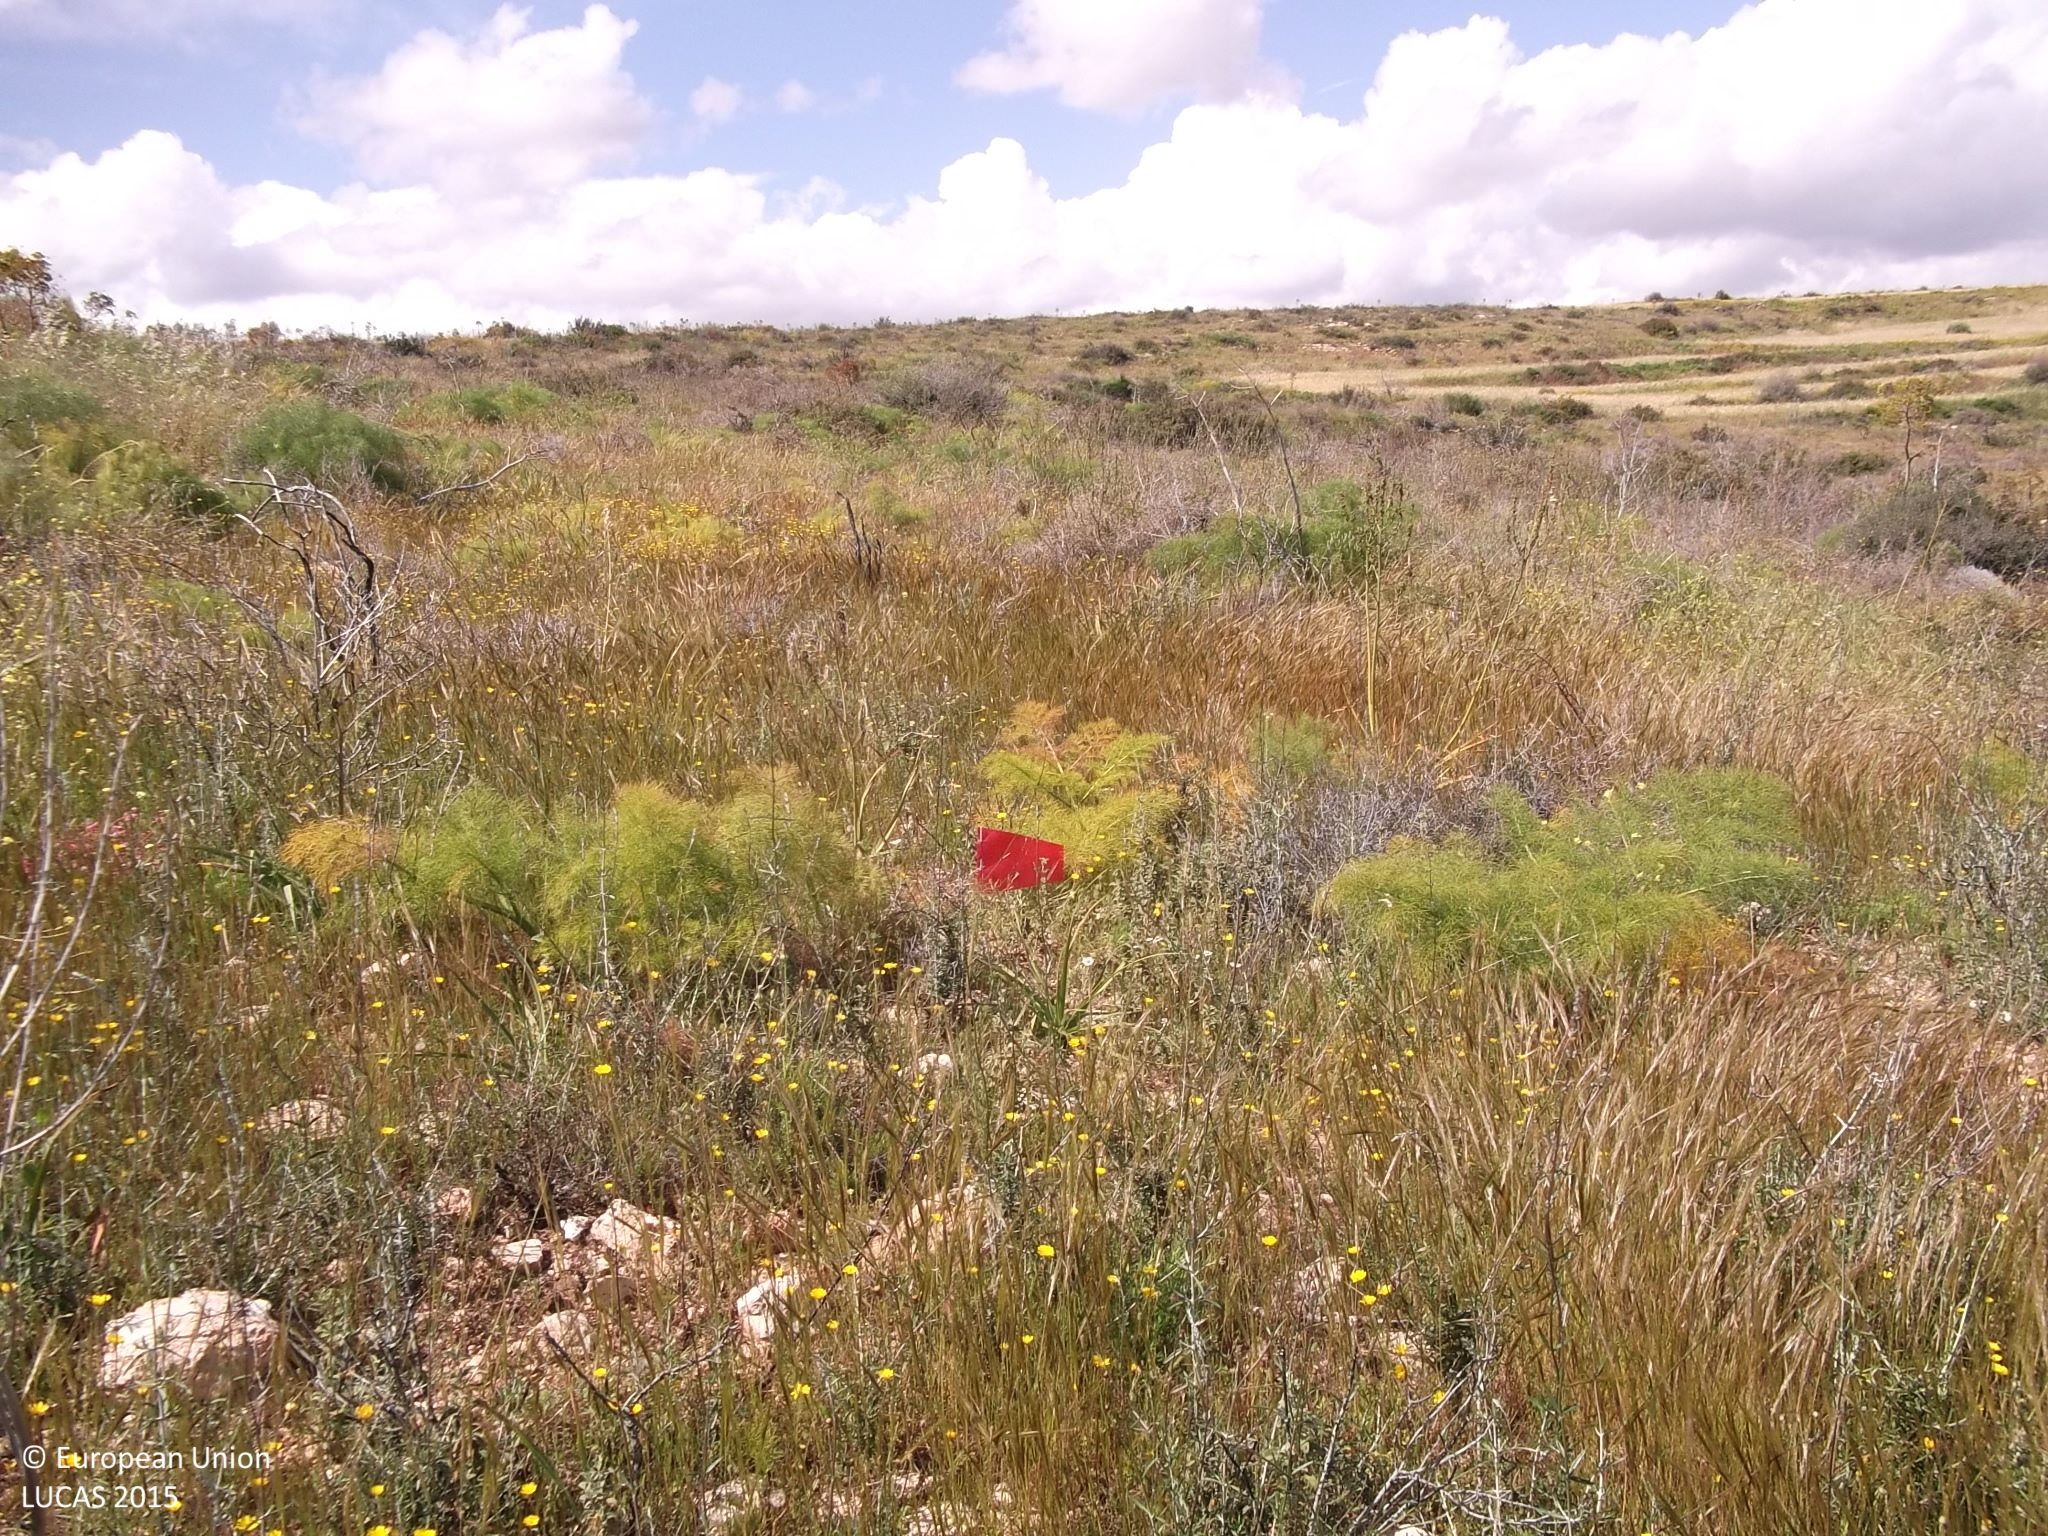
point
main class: Shrubland
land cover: Shrubland without tree cover
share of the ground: 50 - 75 %
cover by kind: shrubs 70 %, herbaceous plants 30 %
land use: Semi-natural and natural areas not in use
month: April
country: CY
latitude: 34.7779
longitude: 33.4256
